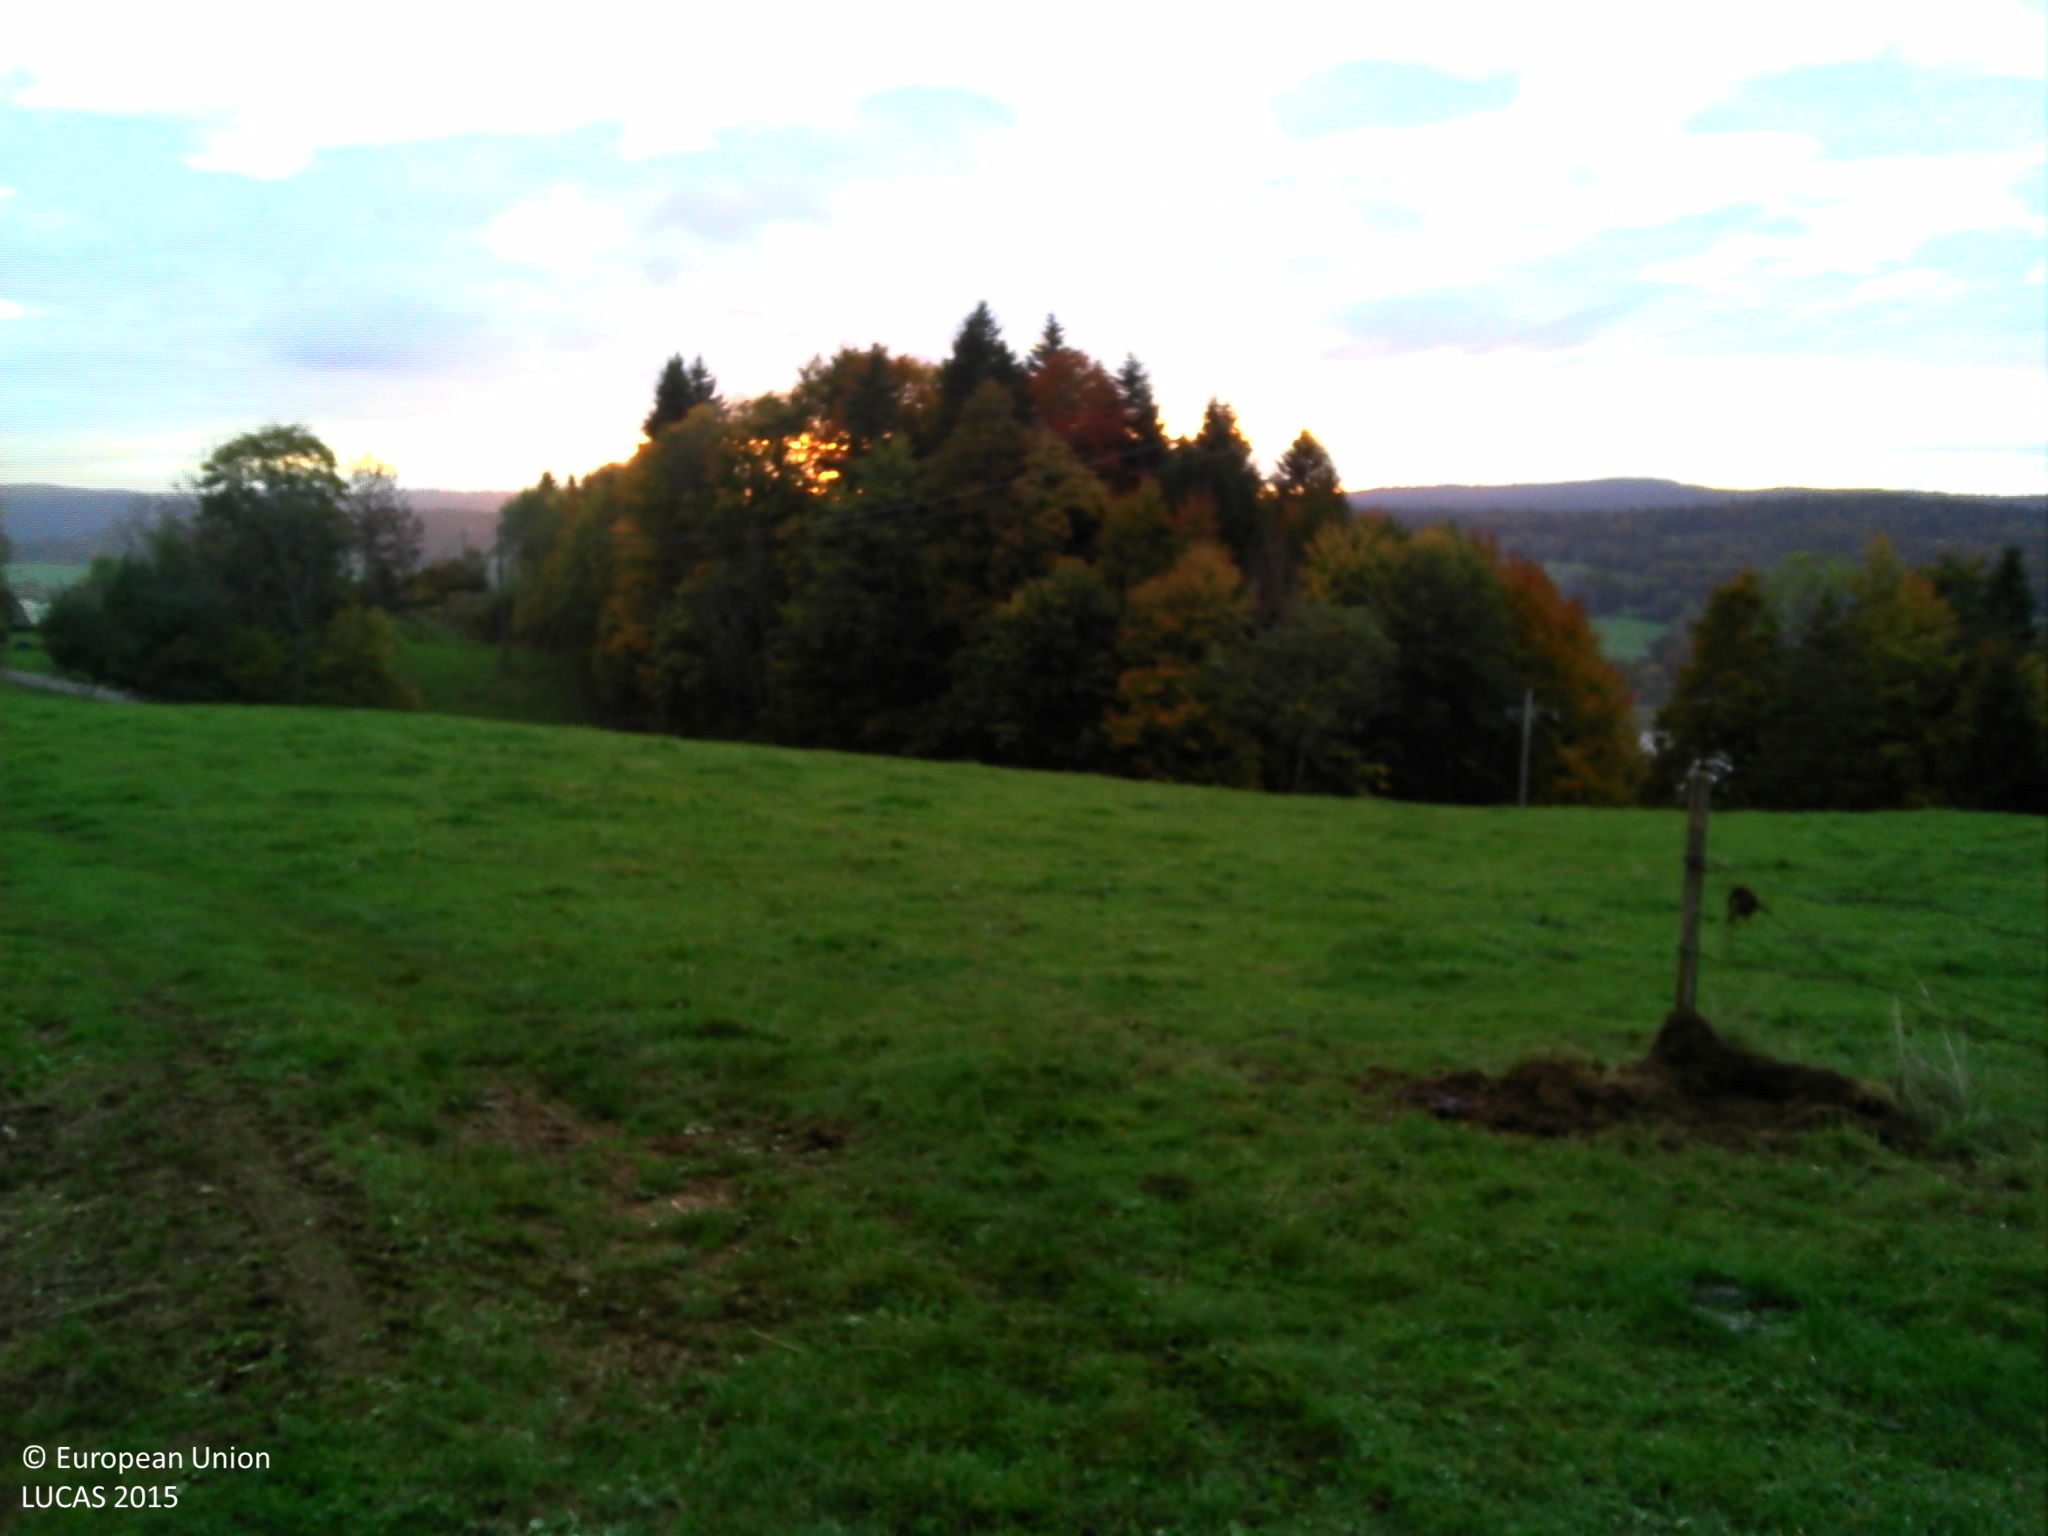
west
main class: Grassland
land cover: Grassland without tree/shrub cover
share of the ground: > 75 %
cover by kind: herbaceous plants 100 %
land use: Agriculture (excluding fallow land and kitchen gardens)
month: October
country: FR
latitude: 46.8296
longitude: 6.3449
